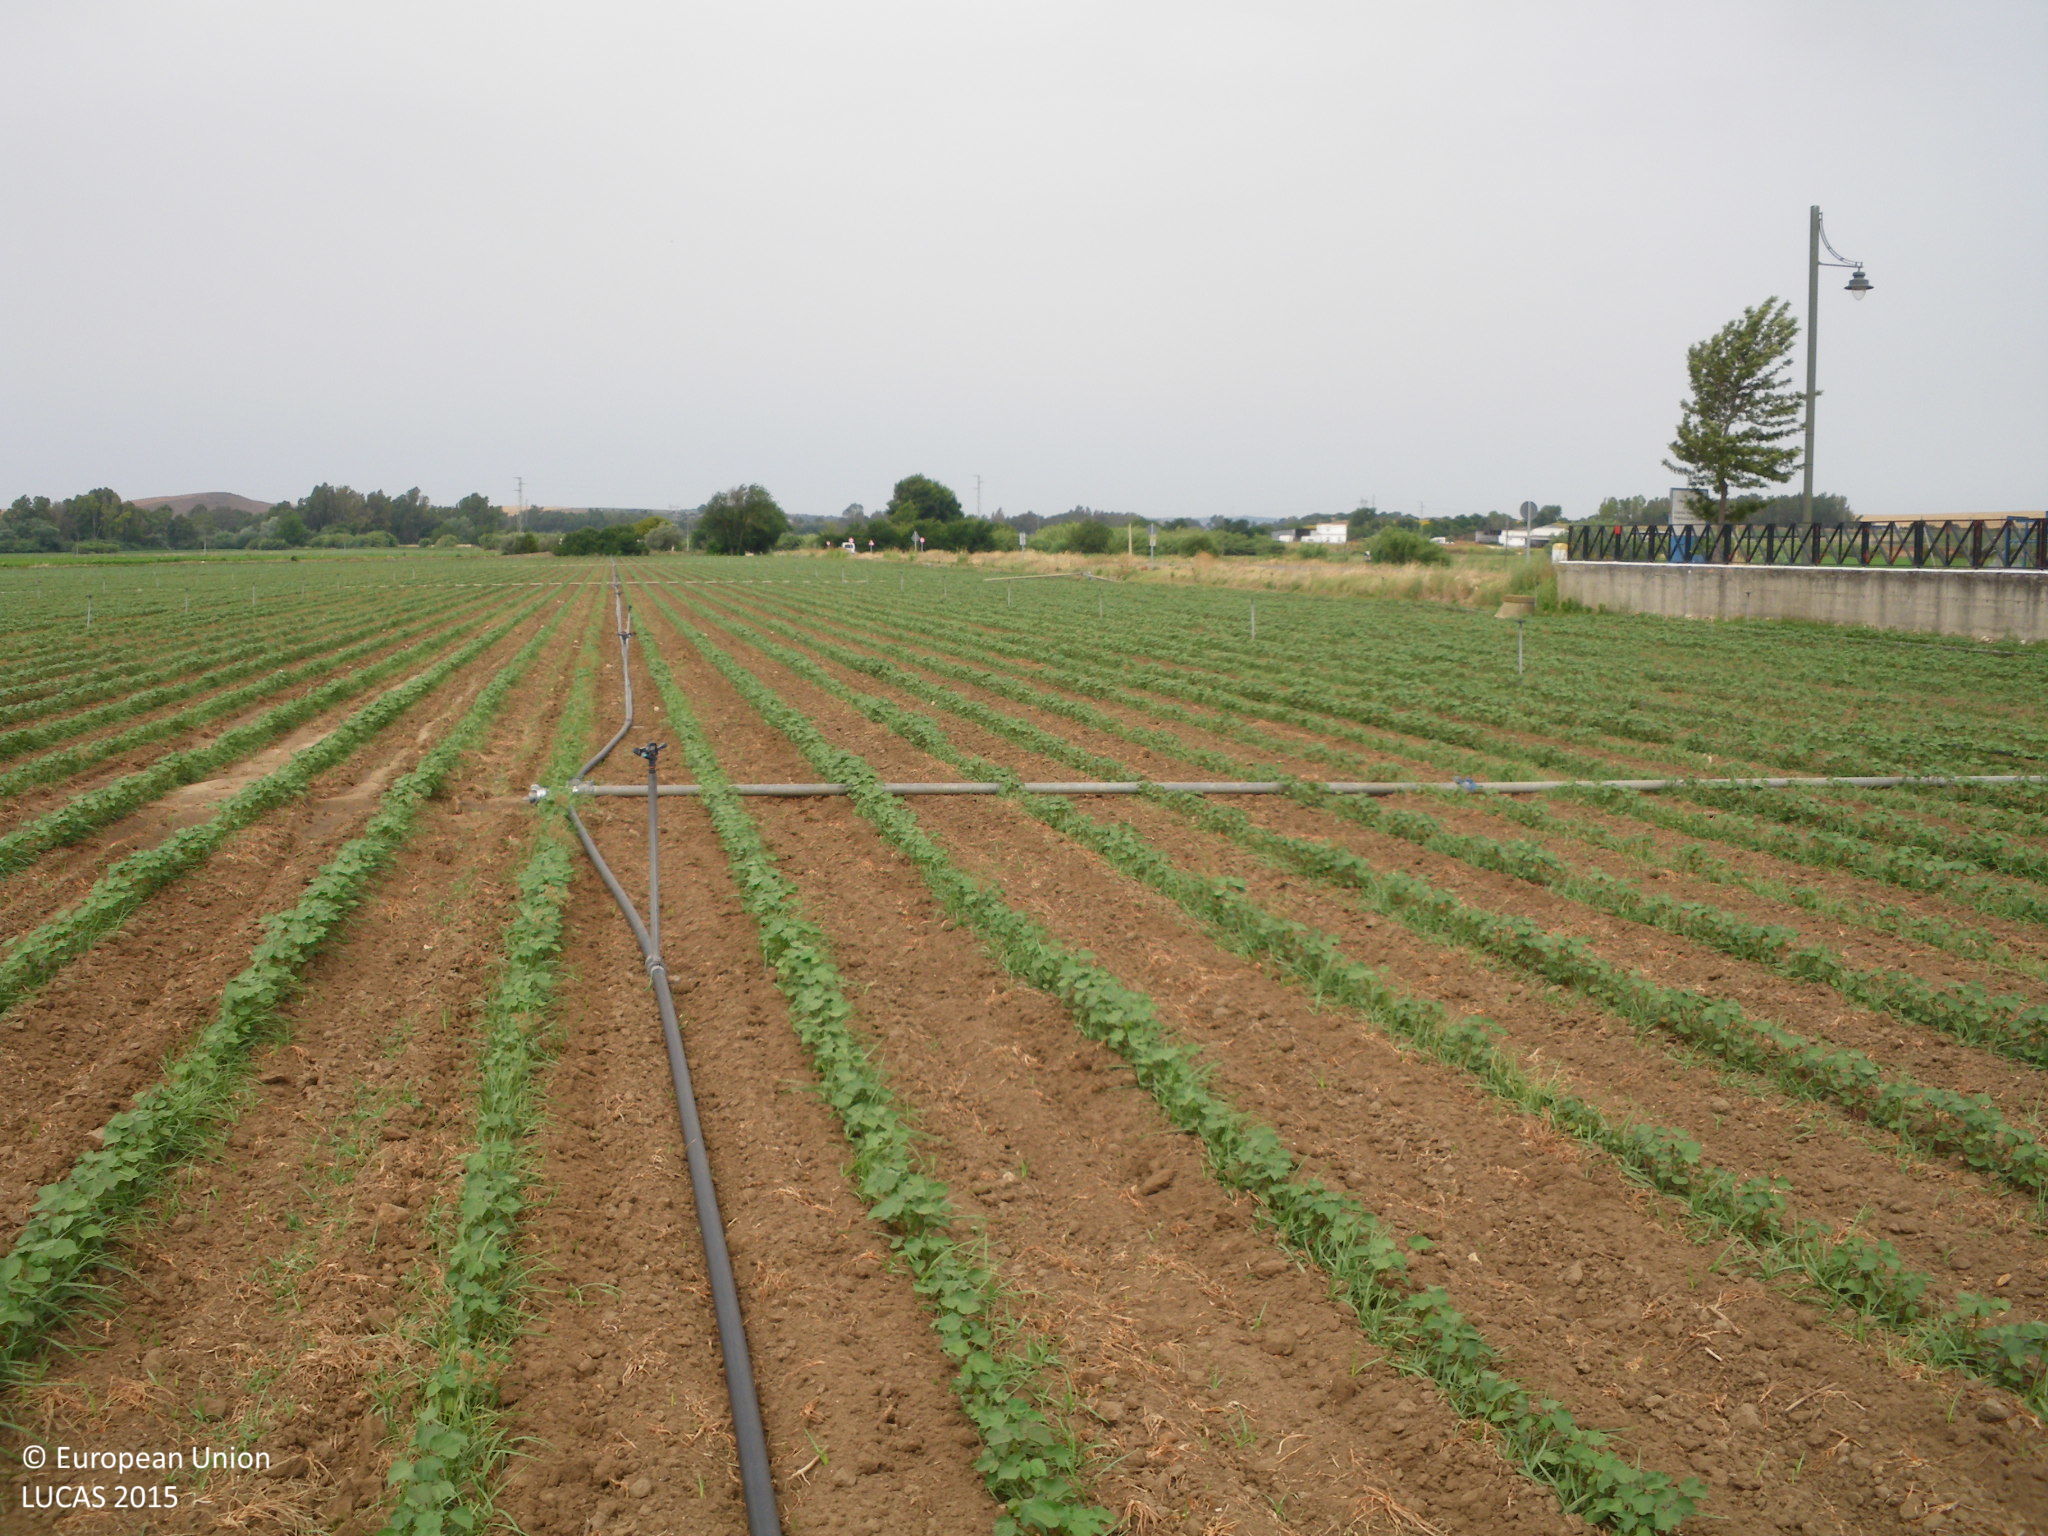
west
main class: Cropland
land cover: Cotton
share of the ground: 10 - 25 %
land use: Agriculture (excluding fallow land and kitchen gardens)
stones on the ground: < 10 %
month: June
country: ES
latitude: 36.6428
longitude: -5.9924
